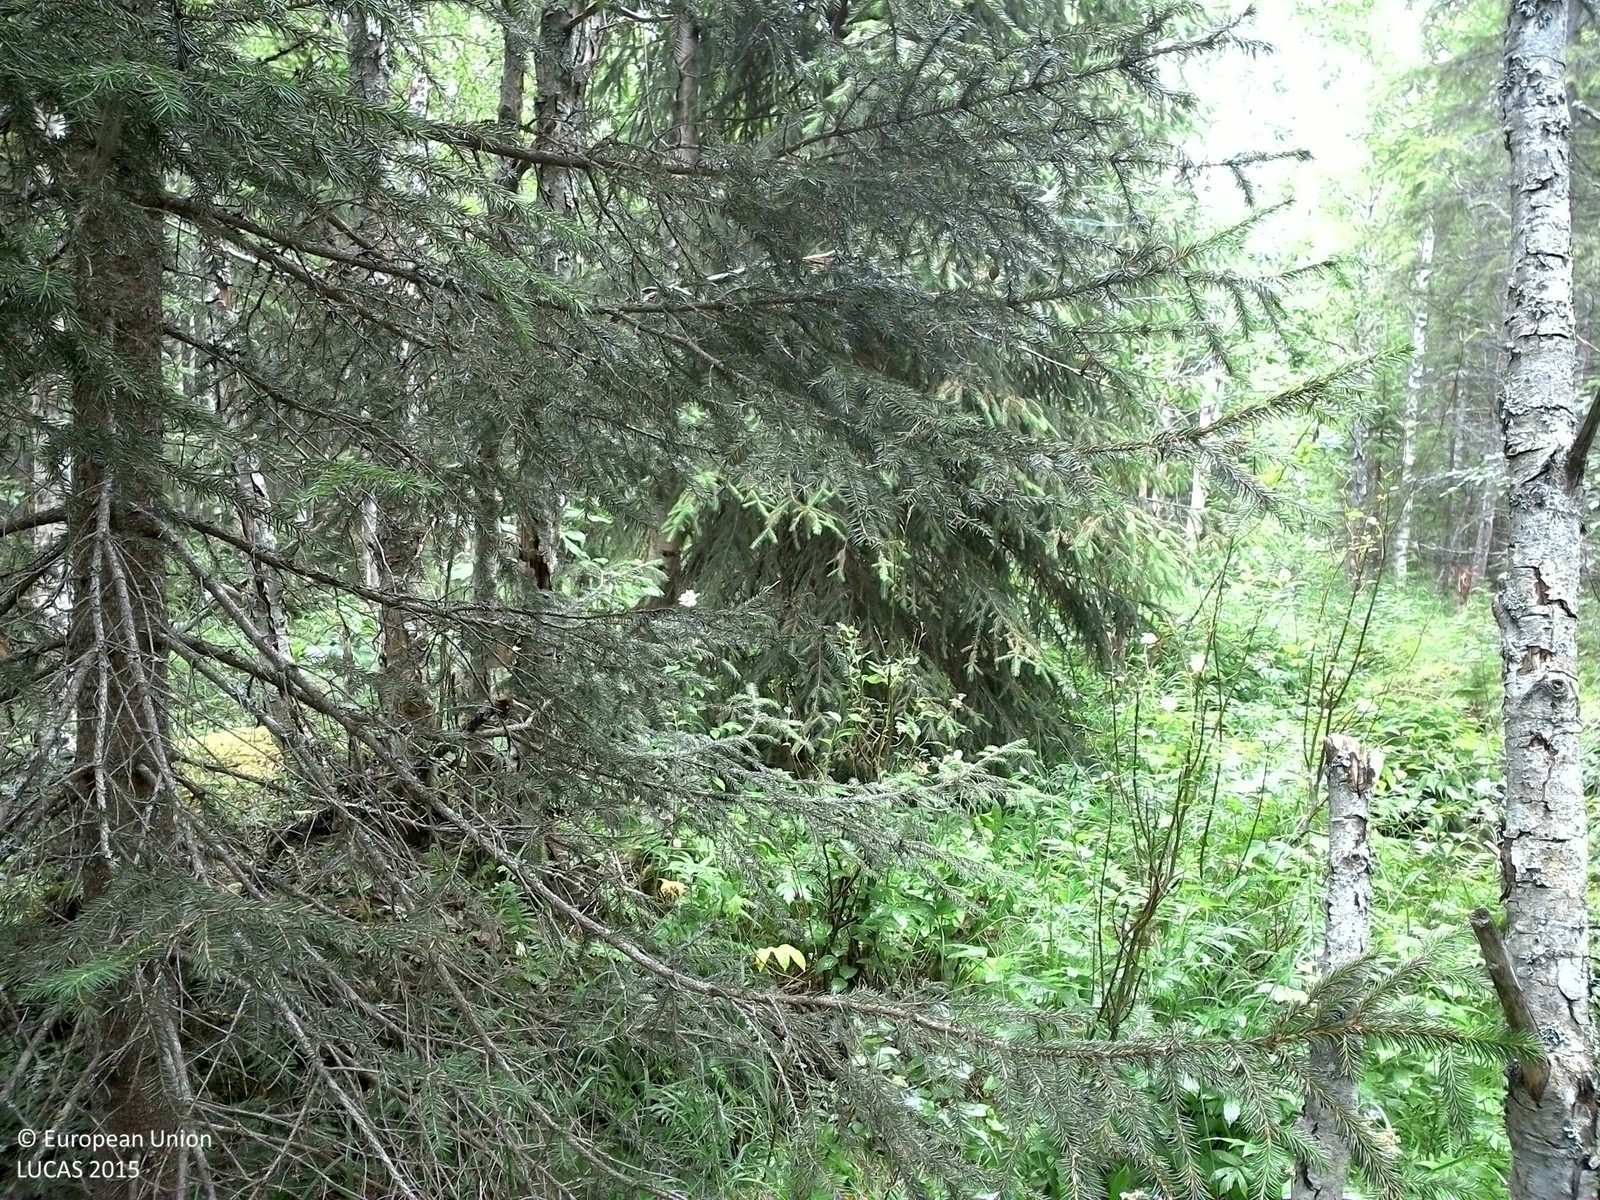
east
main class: Woodland
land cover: Spruce dominated mixed woodland
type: boreal forest
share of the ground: > 75 %
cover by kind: coniferous forest trees 45 %, broadleaved forest trees 40 %, herbaceous plants 15 %
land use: Forestry
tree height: > 5 m
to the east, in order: Rivers and streams; Spruce dominated mixed woodland; Pine dominated coniferous woodland; Ditches and canals; Paved roads, cycling and walking lanes; Pine dominated mixed woodland; Pine dominated coniferous woodland
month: August
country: SE
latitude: 63.6415
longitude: 18.1906
